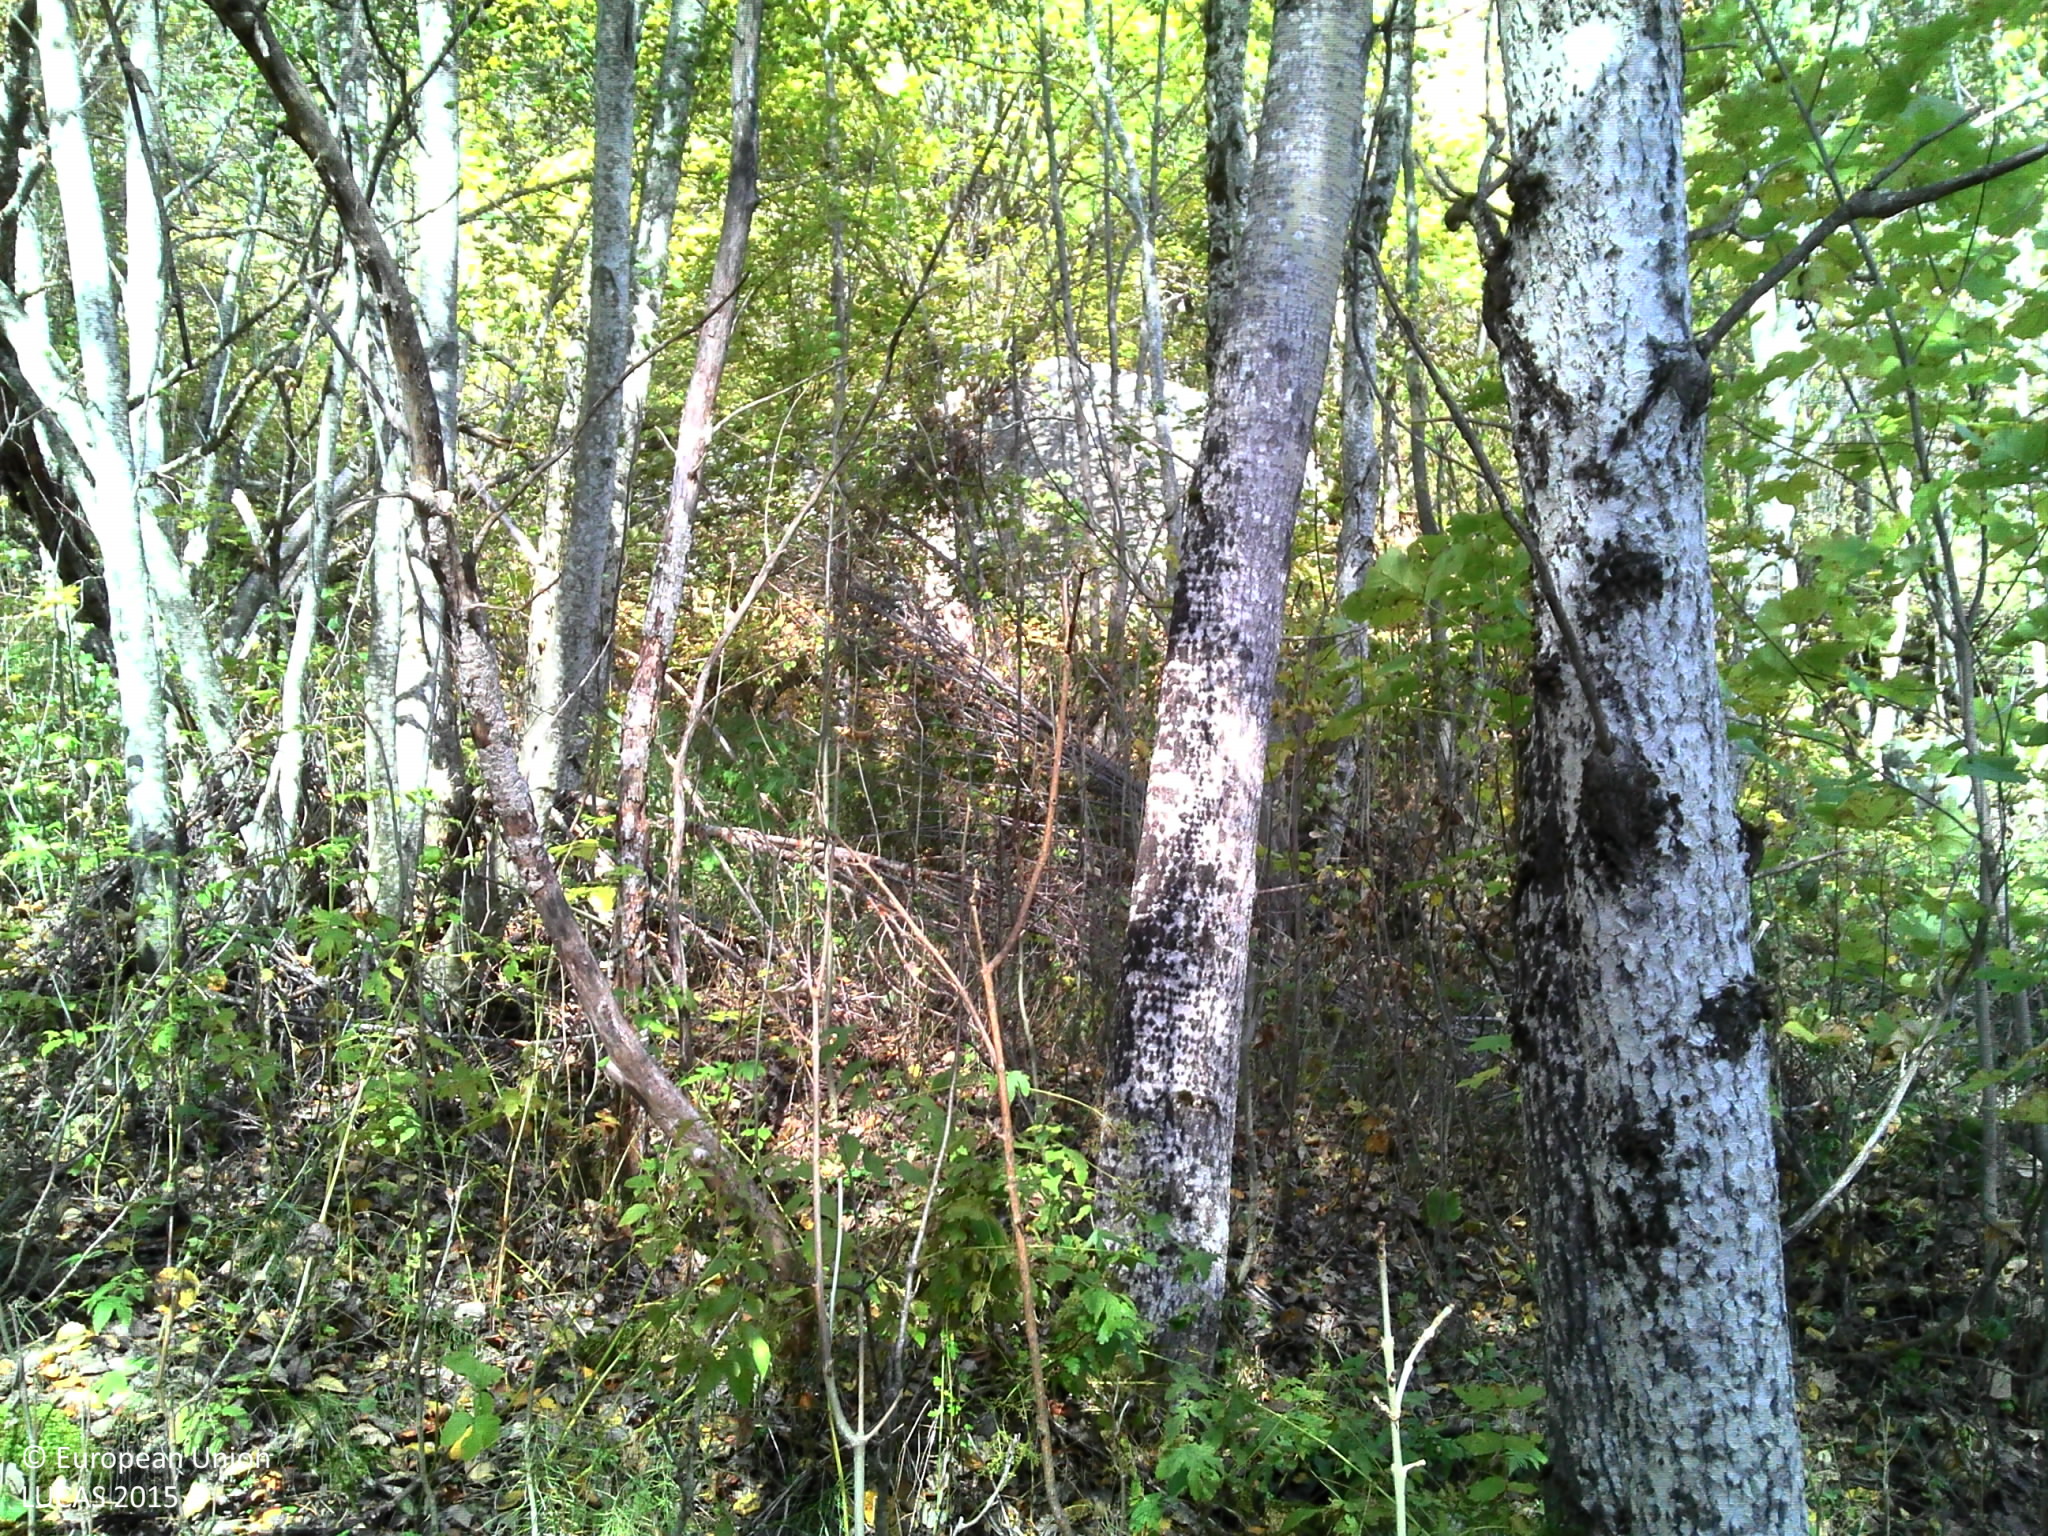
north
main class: Woodland
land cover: Broadleaved woodland
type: mesophytic deciduous forest
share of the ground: > 75 %
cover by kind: broadleaved forest trees 80 %, unconsolidated bare surface 10 %, shrubs 5 %, lichens and mosses 5 %
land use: Forestry
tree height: > 5 m
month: October
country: FR
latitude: 45.2924
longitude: 6.2181
